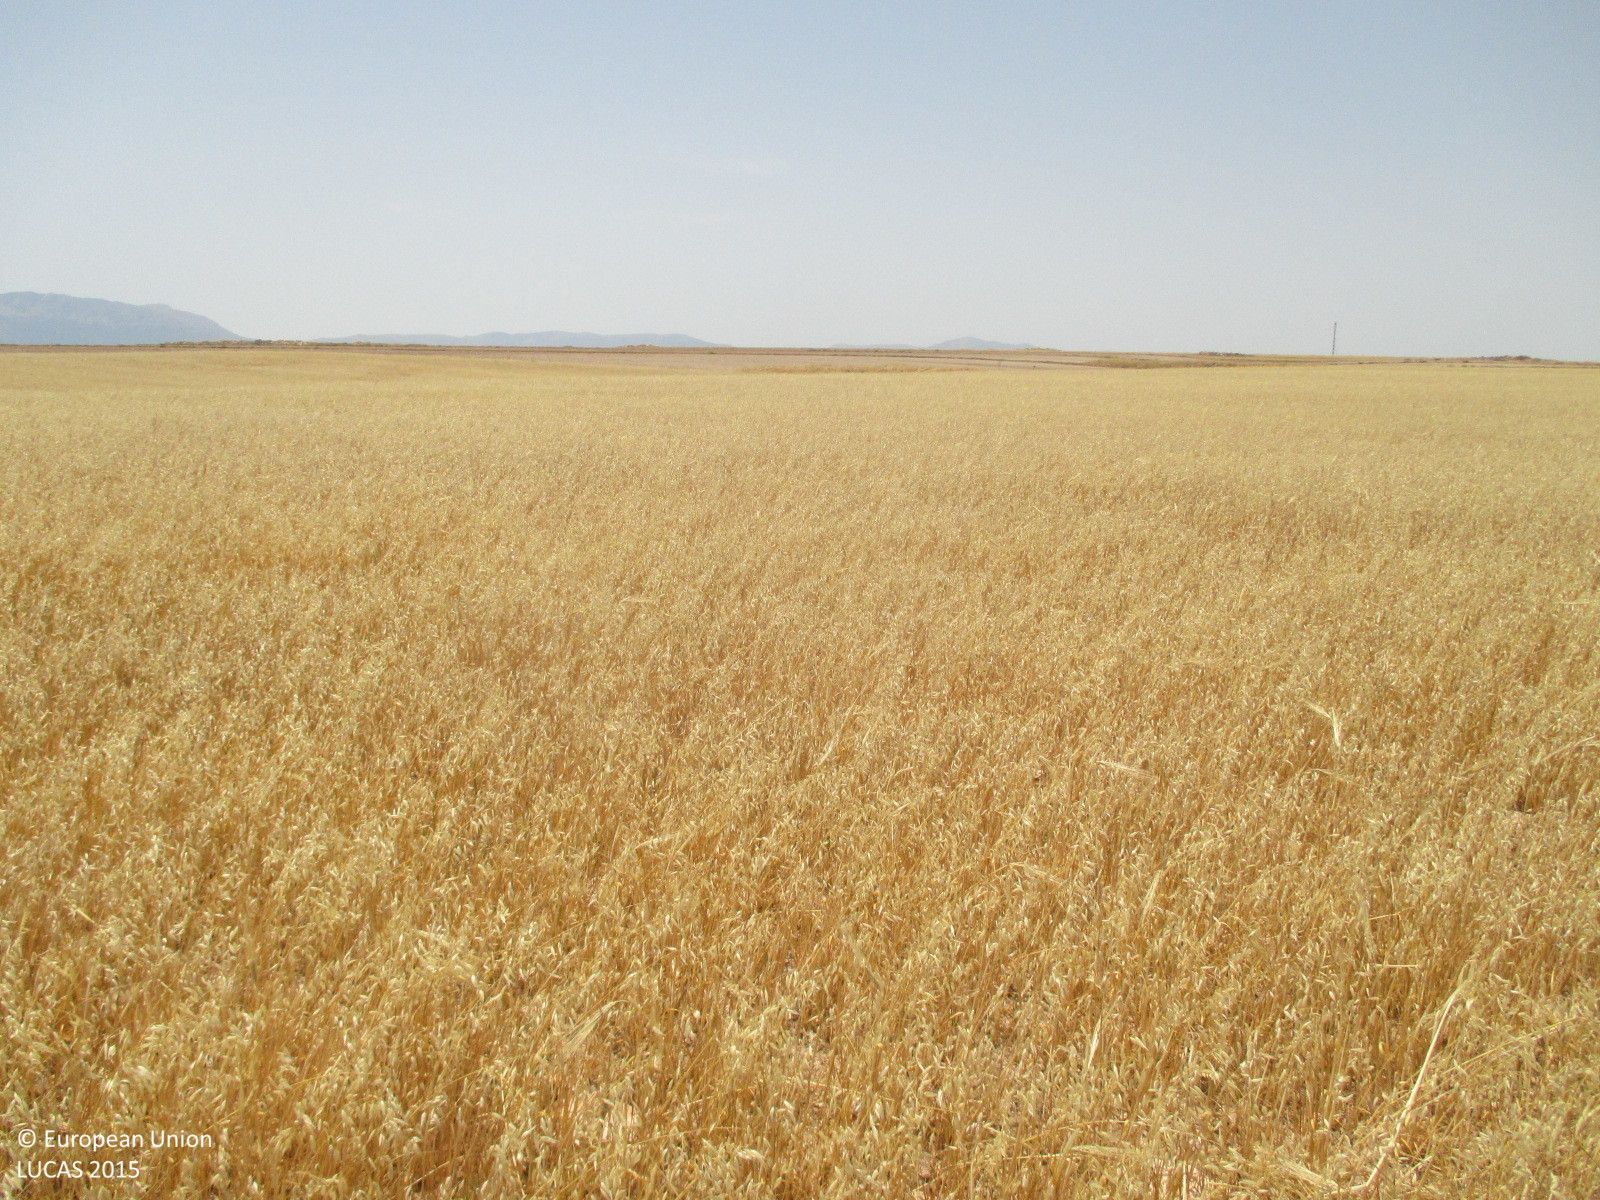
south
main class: Cropland
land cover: Oats
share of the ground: > 75 %
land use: Agriculture (excluding fallow land and kitchen gardens)
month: July
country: ES
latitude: 37.8261
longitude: -2.2925
